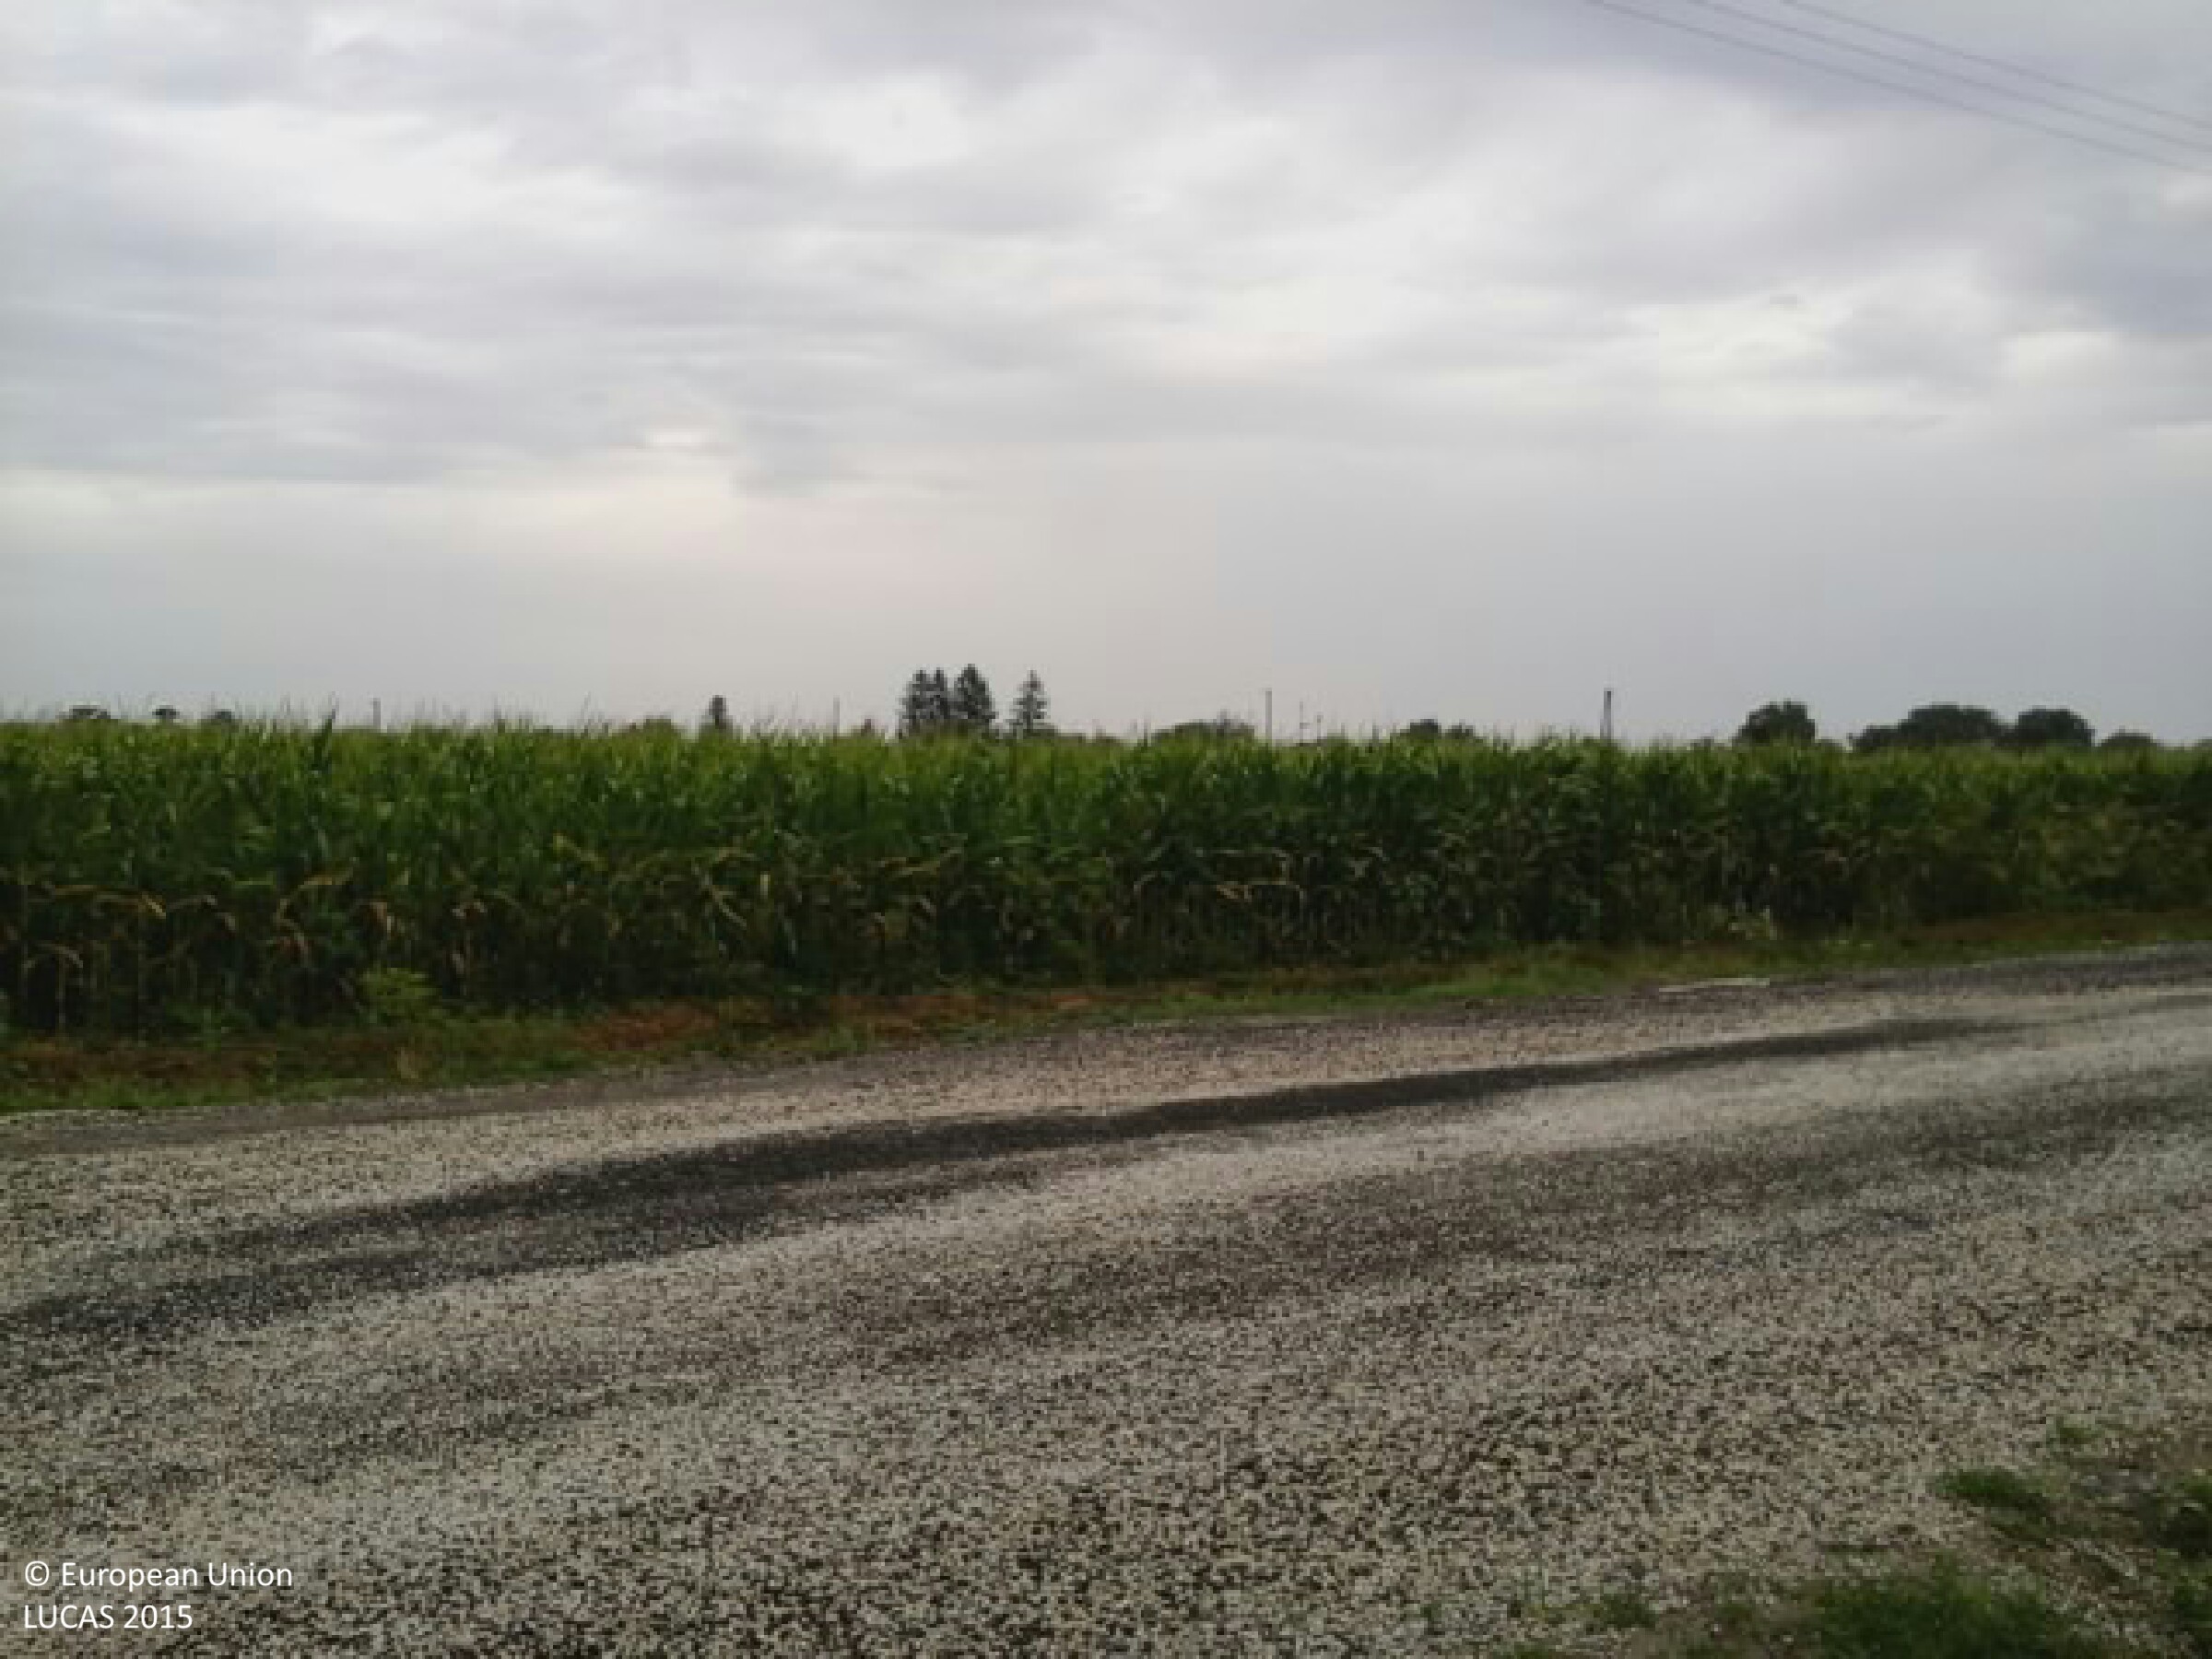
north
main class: Cropland
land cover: Sunflower
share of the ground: > 75 %
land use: Agriculture (excluding fallow land and kitchen gardens)
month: July
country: HU
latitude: 46.3831
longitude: 18.8407
